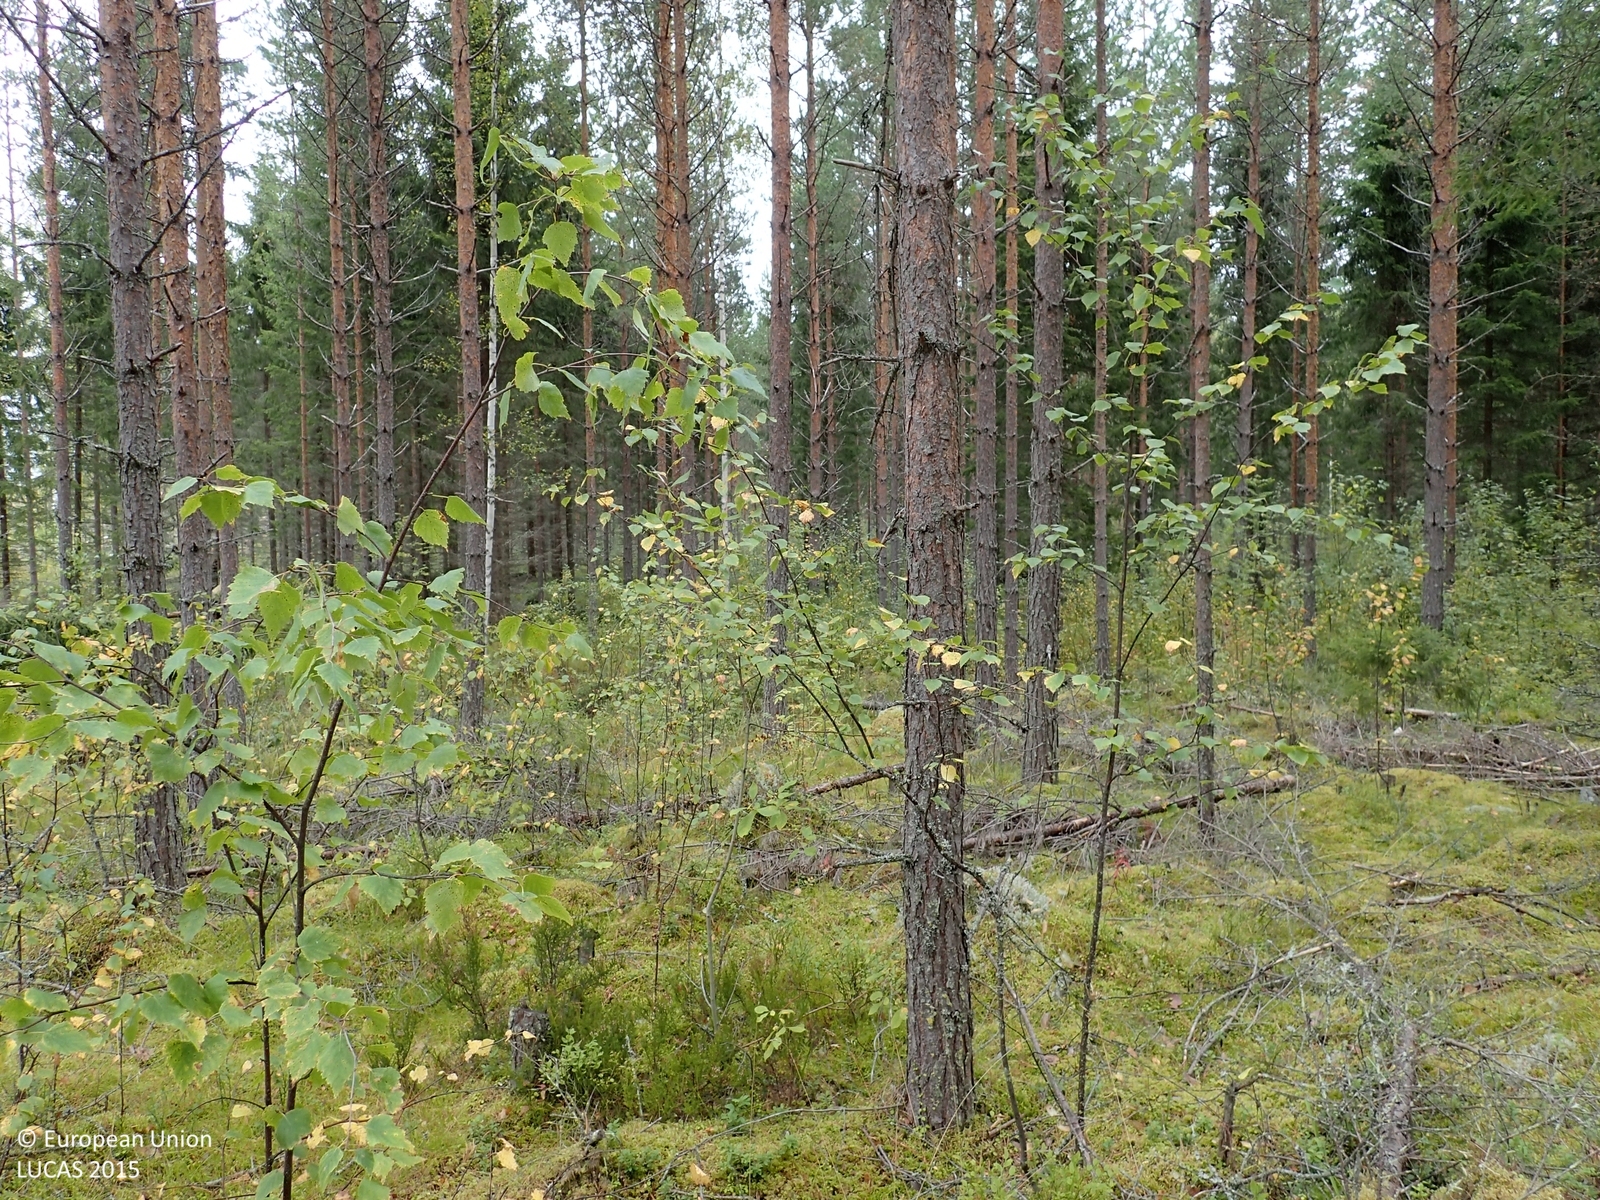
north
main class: Woodland
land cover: Pine dominated mixed woodland
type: boreal forest
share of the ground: > 75 %
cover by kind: coniferous forest trees 55 %, broadleaved forest trees 20 %, lichens and mosses 15 %, shrubs 10 %
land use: Forestry
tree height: > 5 m
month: September
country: FI
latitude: 62.9979
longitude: 25.8903
